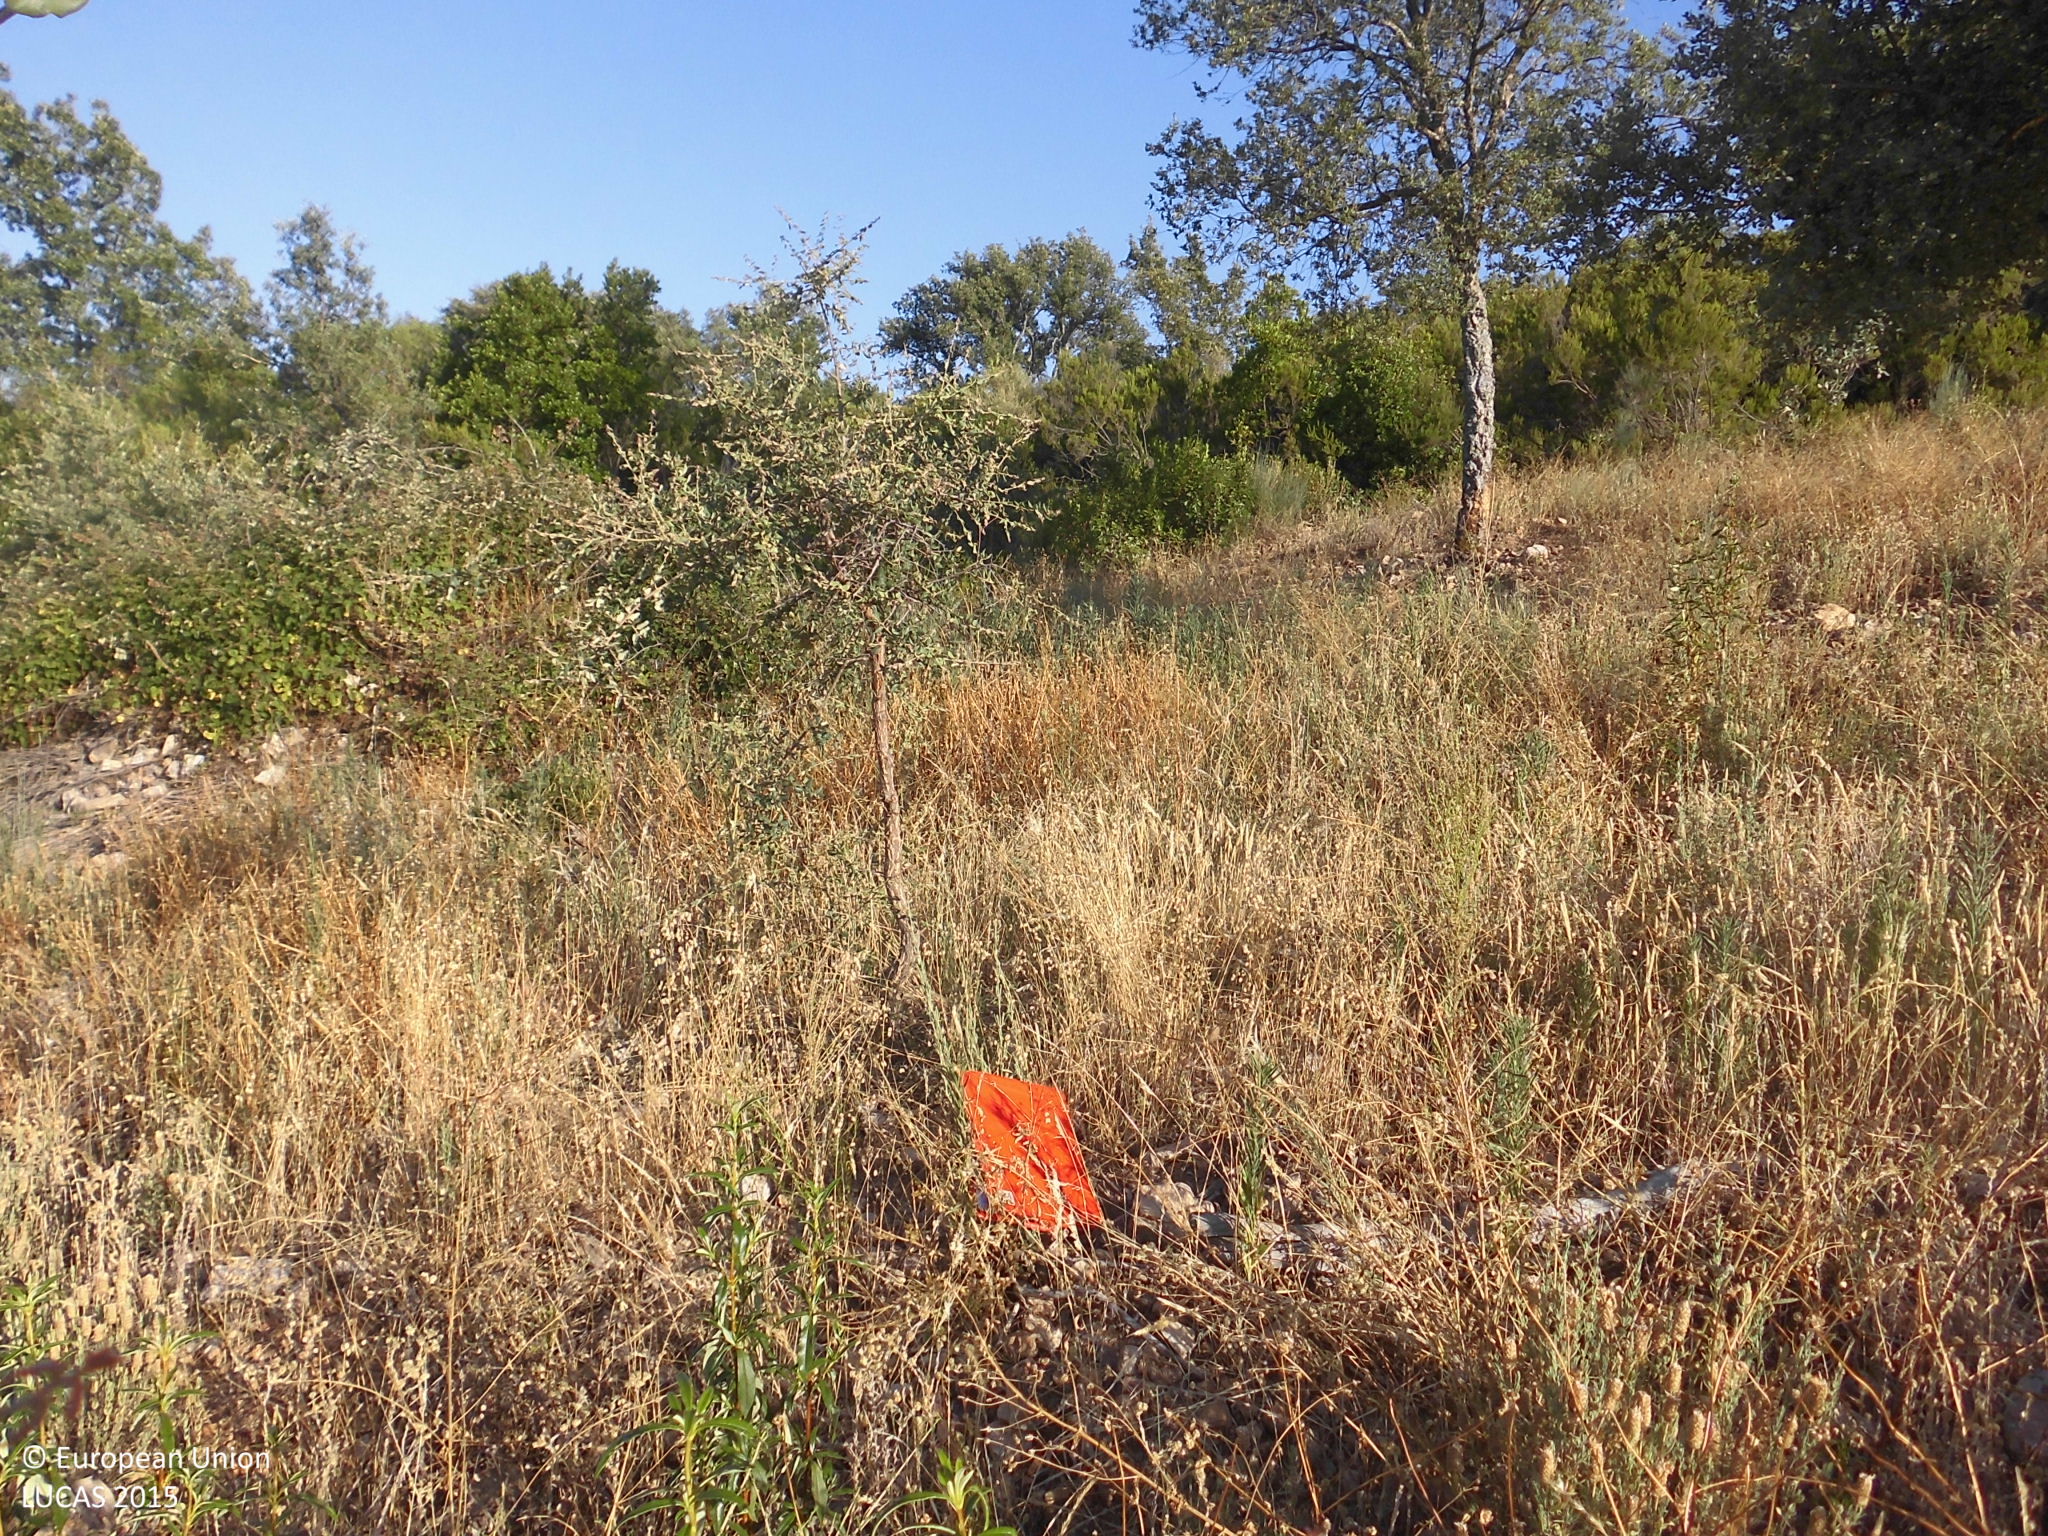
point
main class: Woodland
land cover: Broadleaved woodland
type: broadleaved evergreen forest
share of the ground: 10 - 25 %
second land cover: Grassland without tree/shrub cover
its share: > 75 %
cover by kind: herbaceous plants 90 %, broadleaved forest trees 10 %
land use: Forestry
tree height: < 5 m
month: July
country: ES
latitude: 39.6063
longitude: -5.5564
